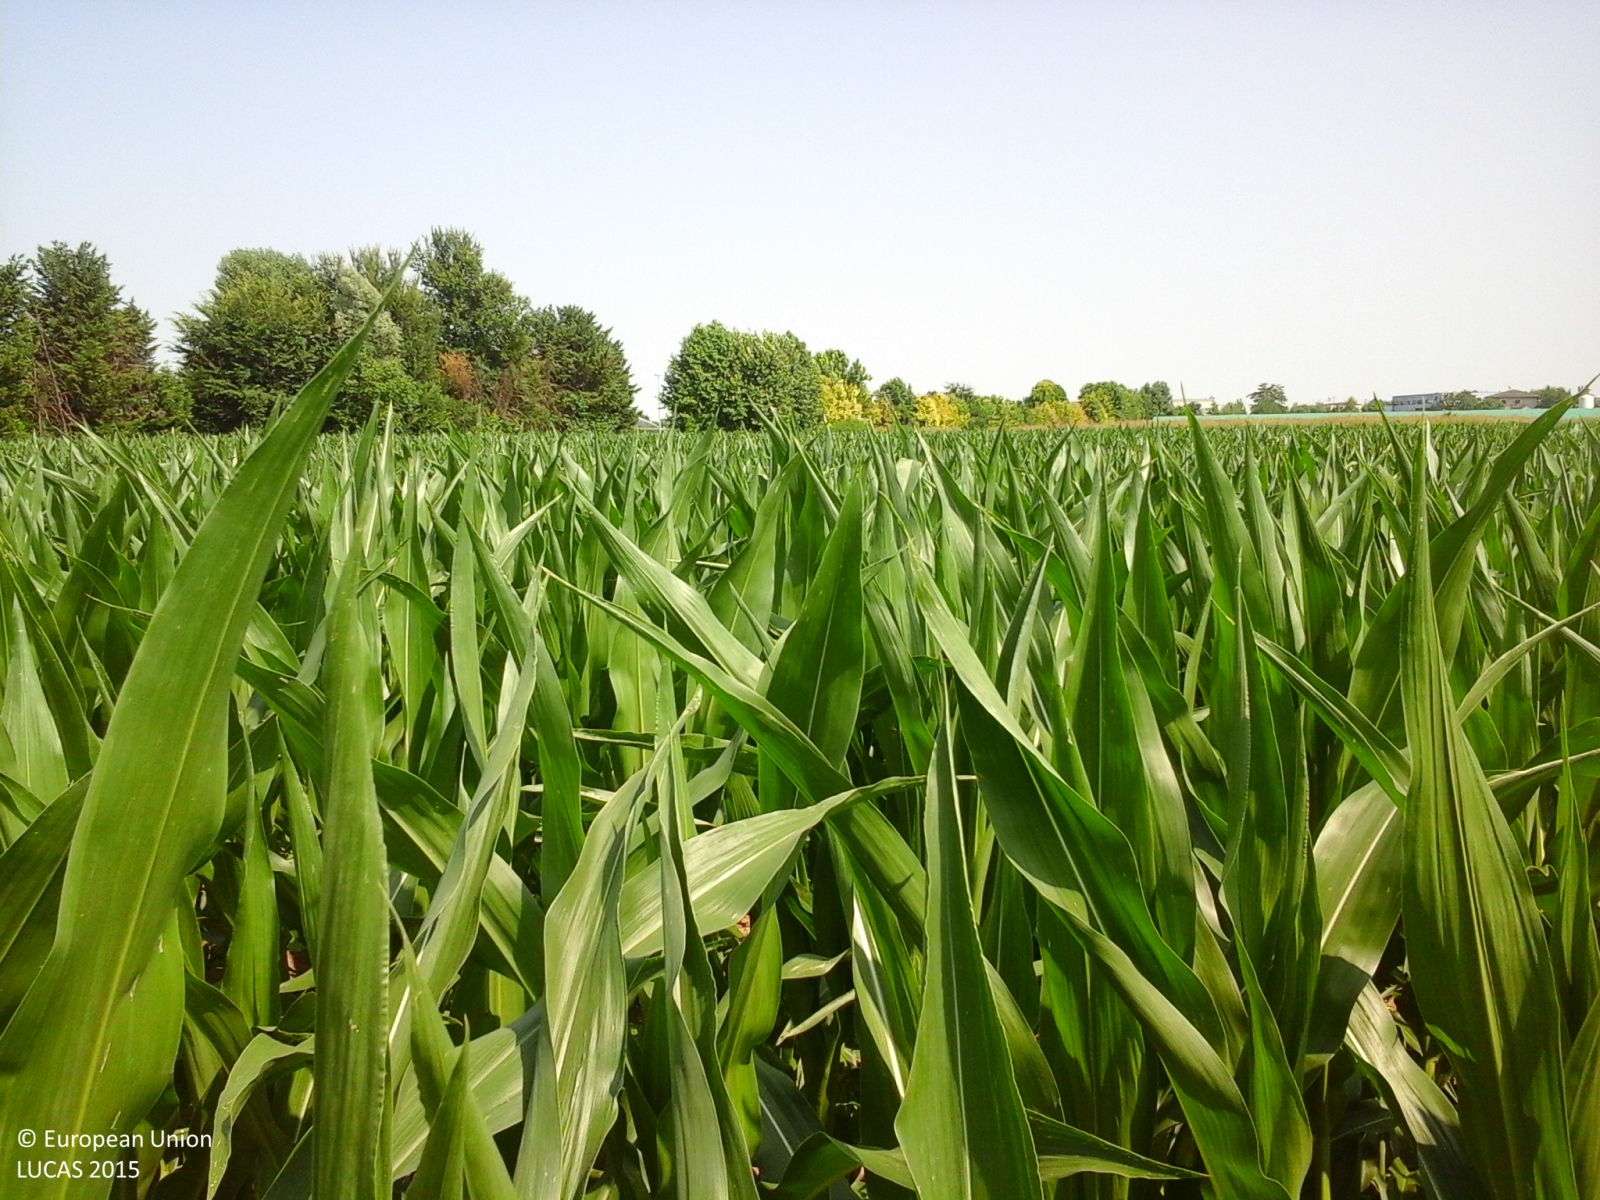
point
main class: Cropland
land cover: Maize
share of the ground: > 75 %
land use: Agriculture (excluding fallow land and kitchen gardens)
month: July
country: IT
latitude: 45.2847
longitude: 10.8527
